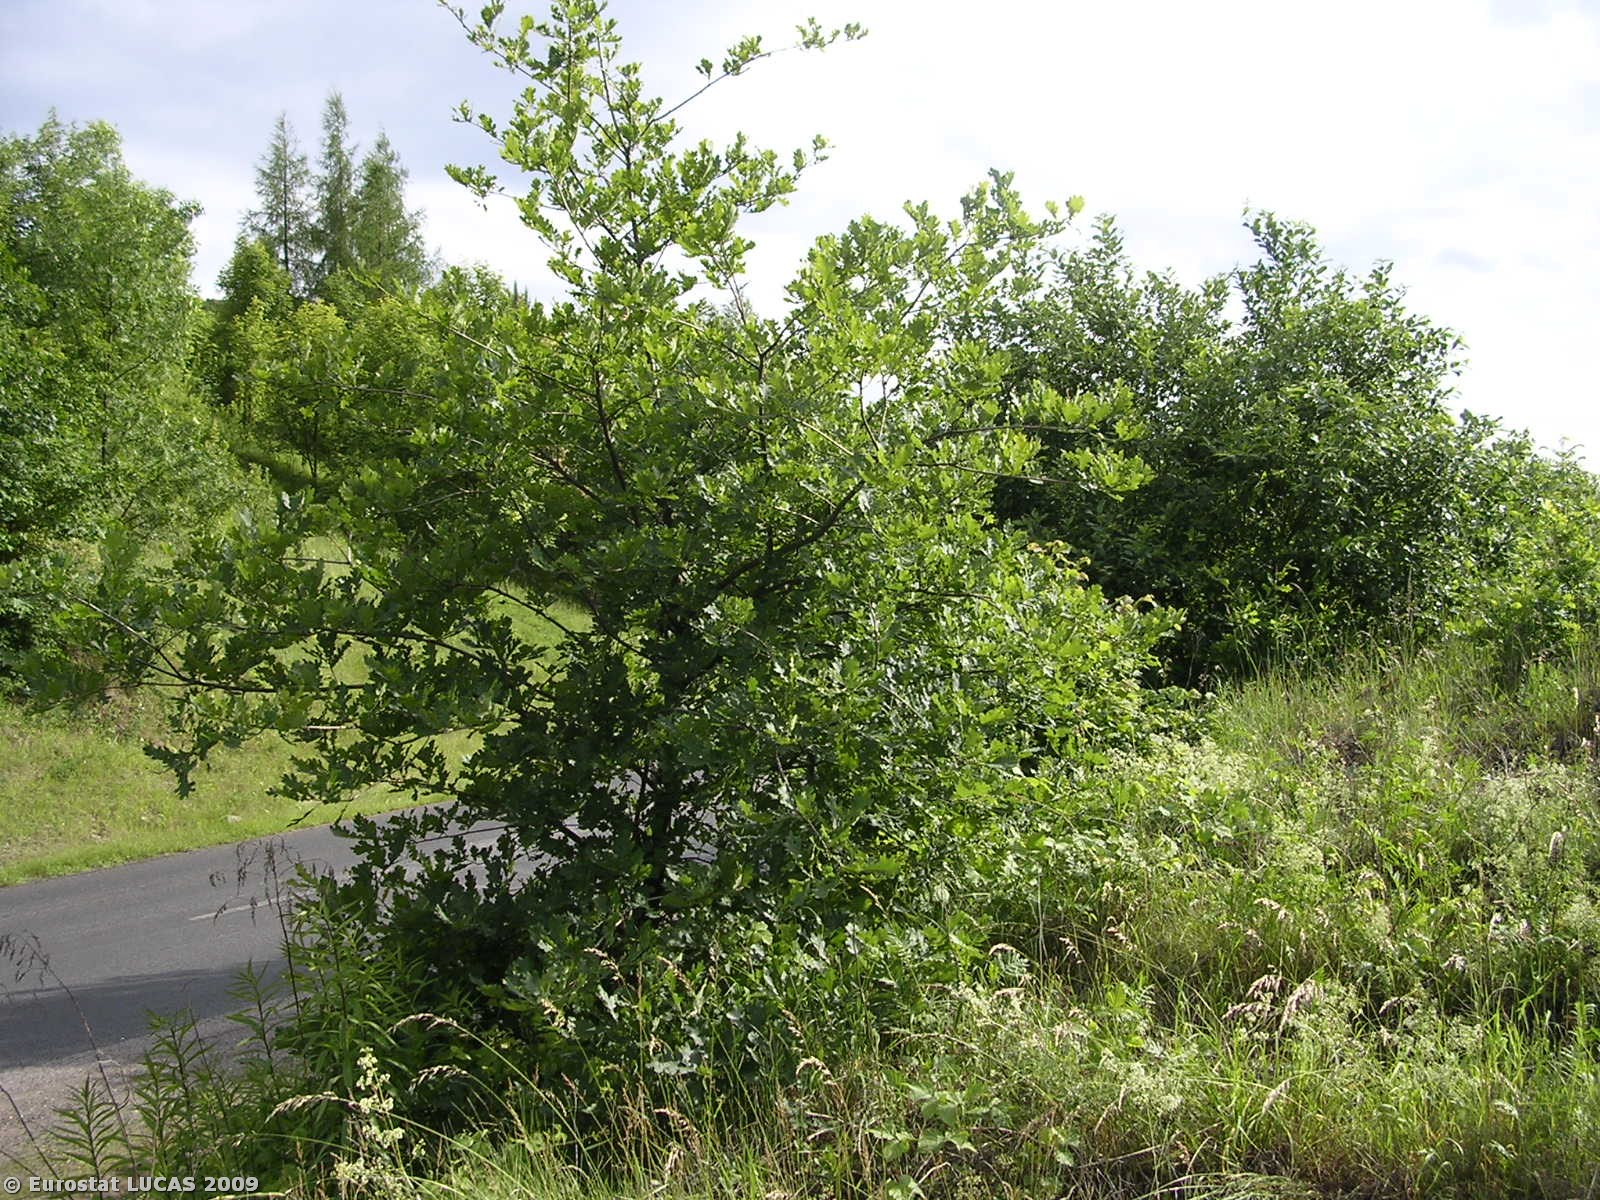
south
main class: Grassland
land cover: Spontaneously vegetated surfaces
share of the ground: 50 - 75 %
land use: Unused
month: June
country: CZ
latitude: 50.6191
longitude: 13.9726
